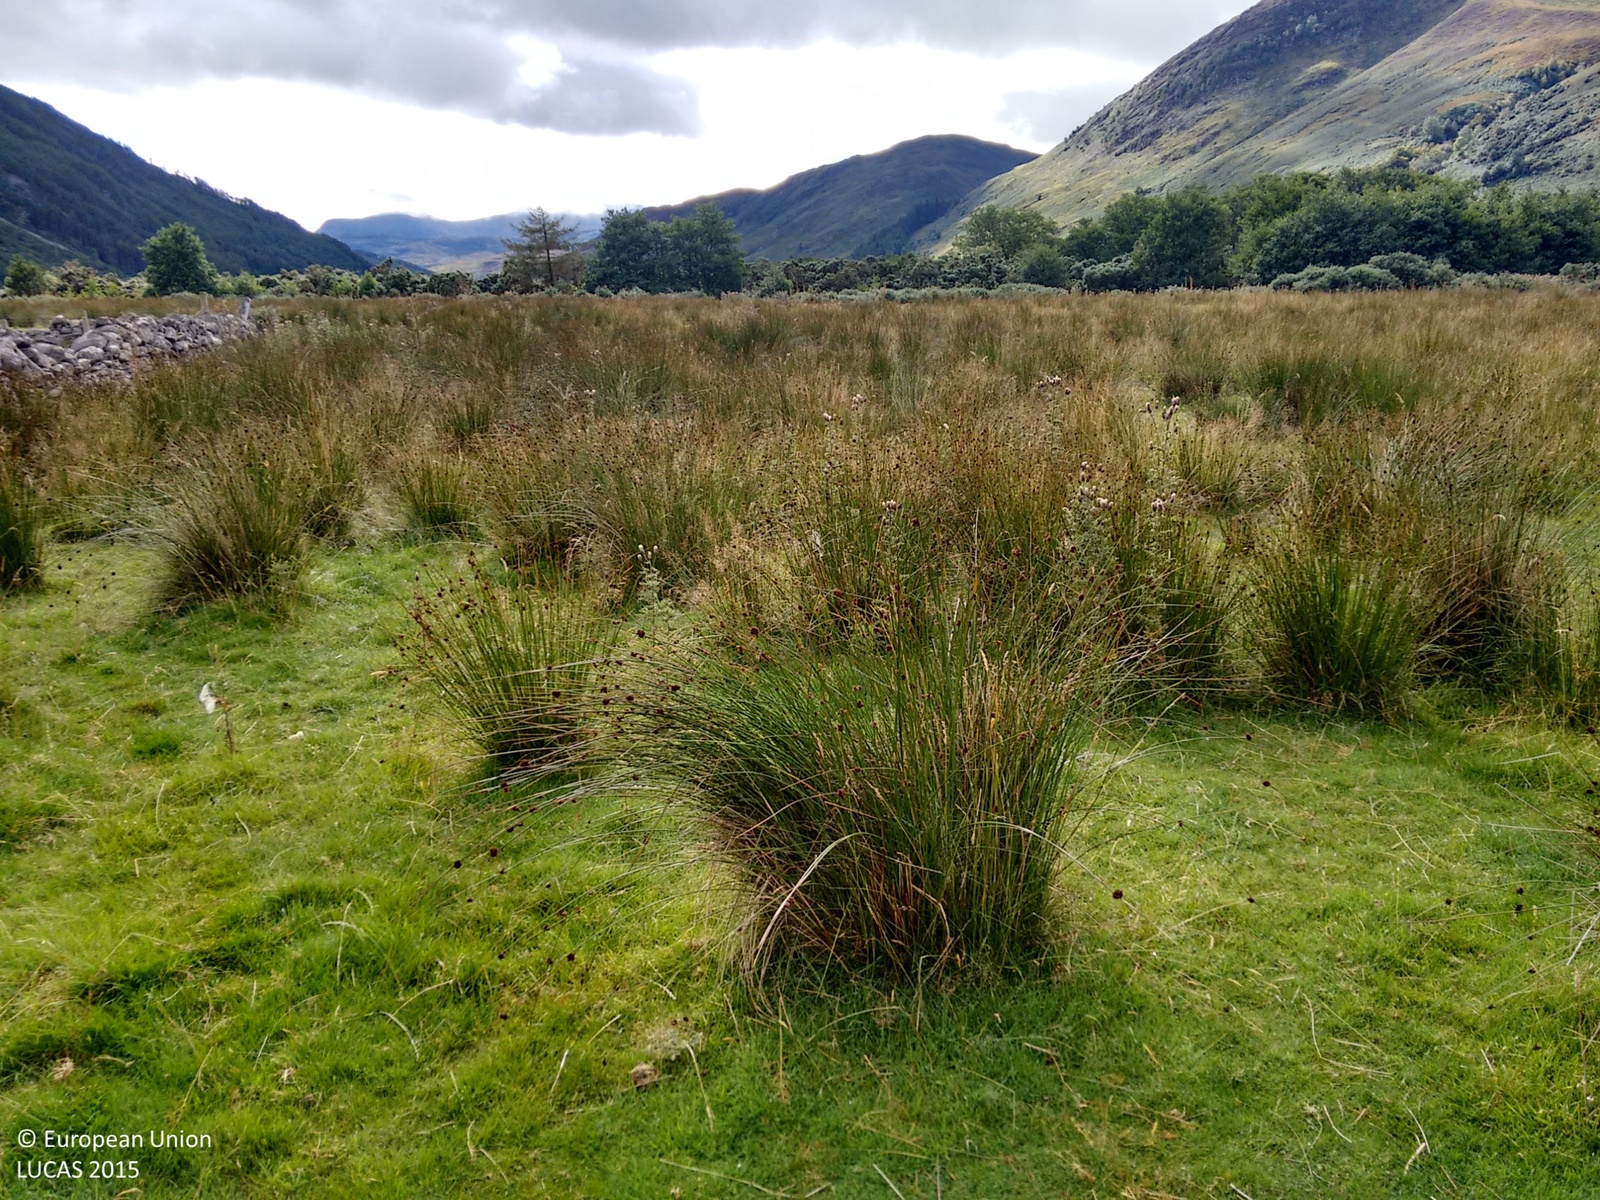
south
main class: Grassland
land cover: Grassland without tree/shrub cover
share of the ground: > 75 %
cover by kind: herbaceous plants 100 %
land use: Agriculture (excluding fallow land and kitchen gardens)
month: September
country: GB
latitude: 57.8214
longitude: -5.0692
